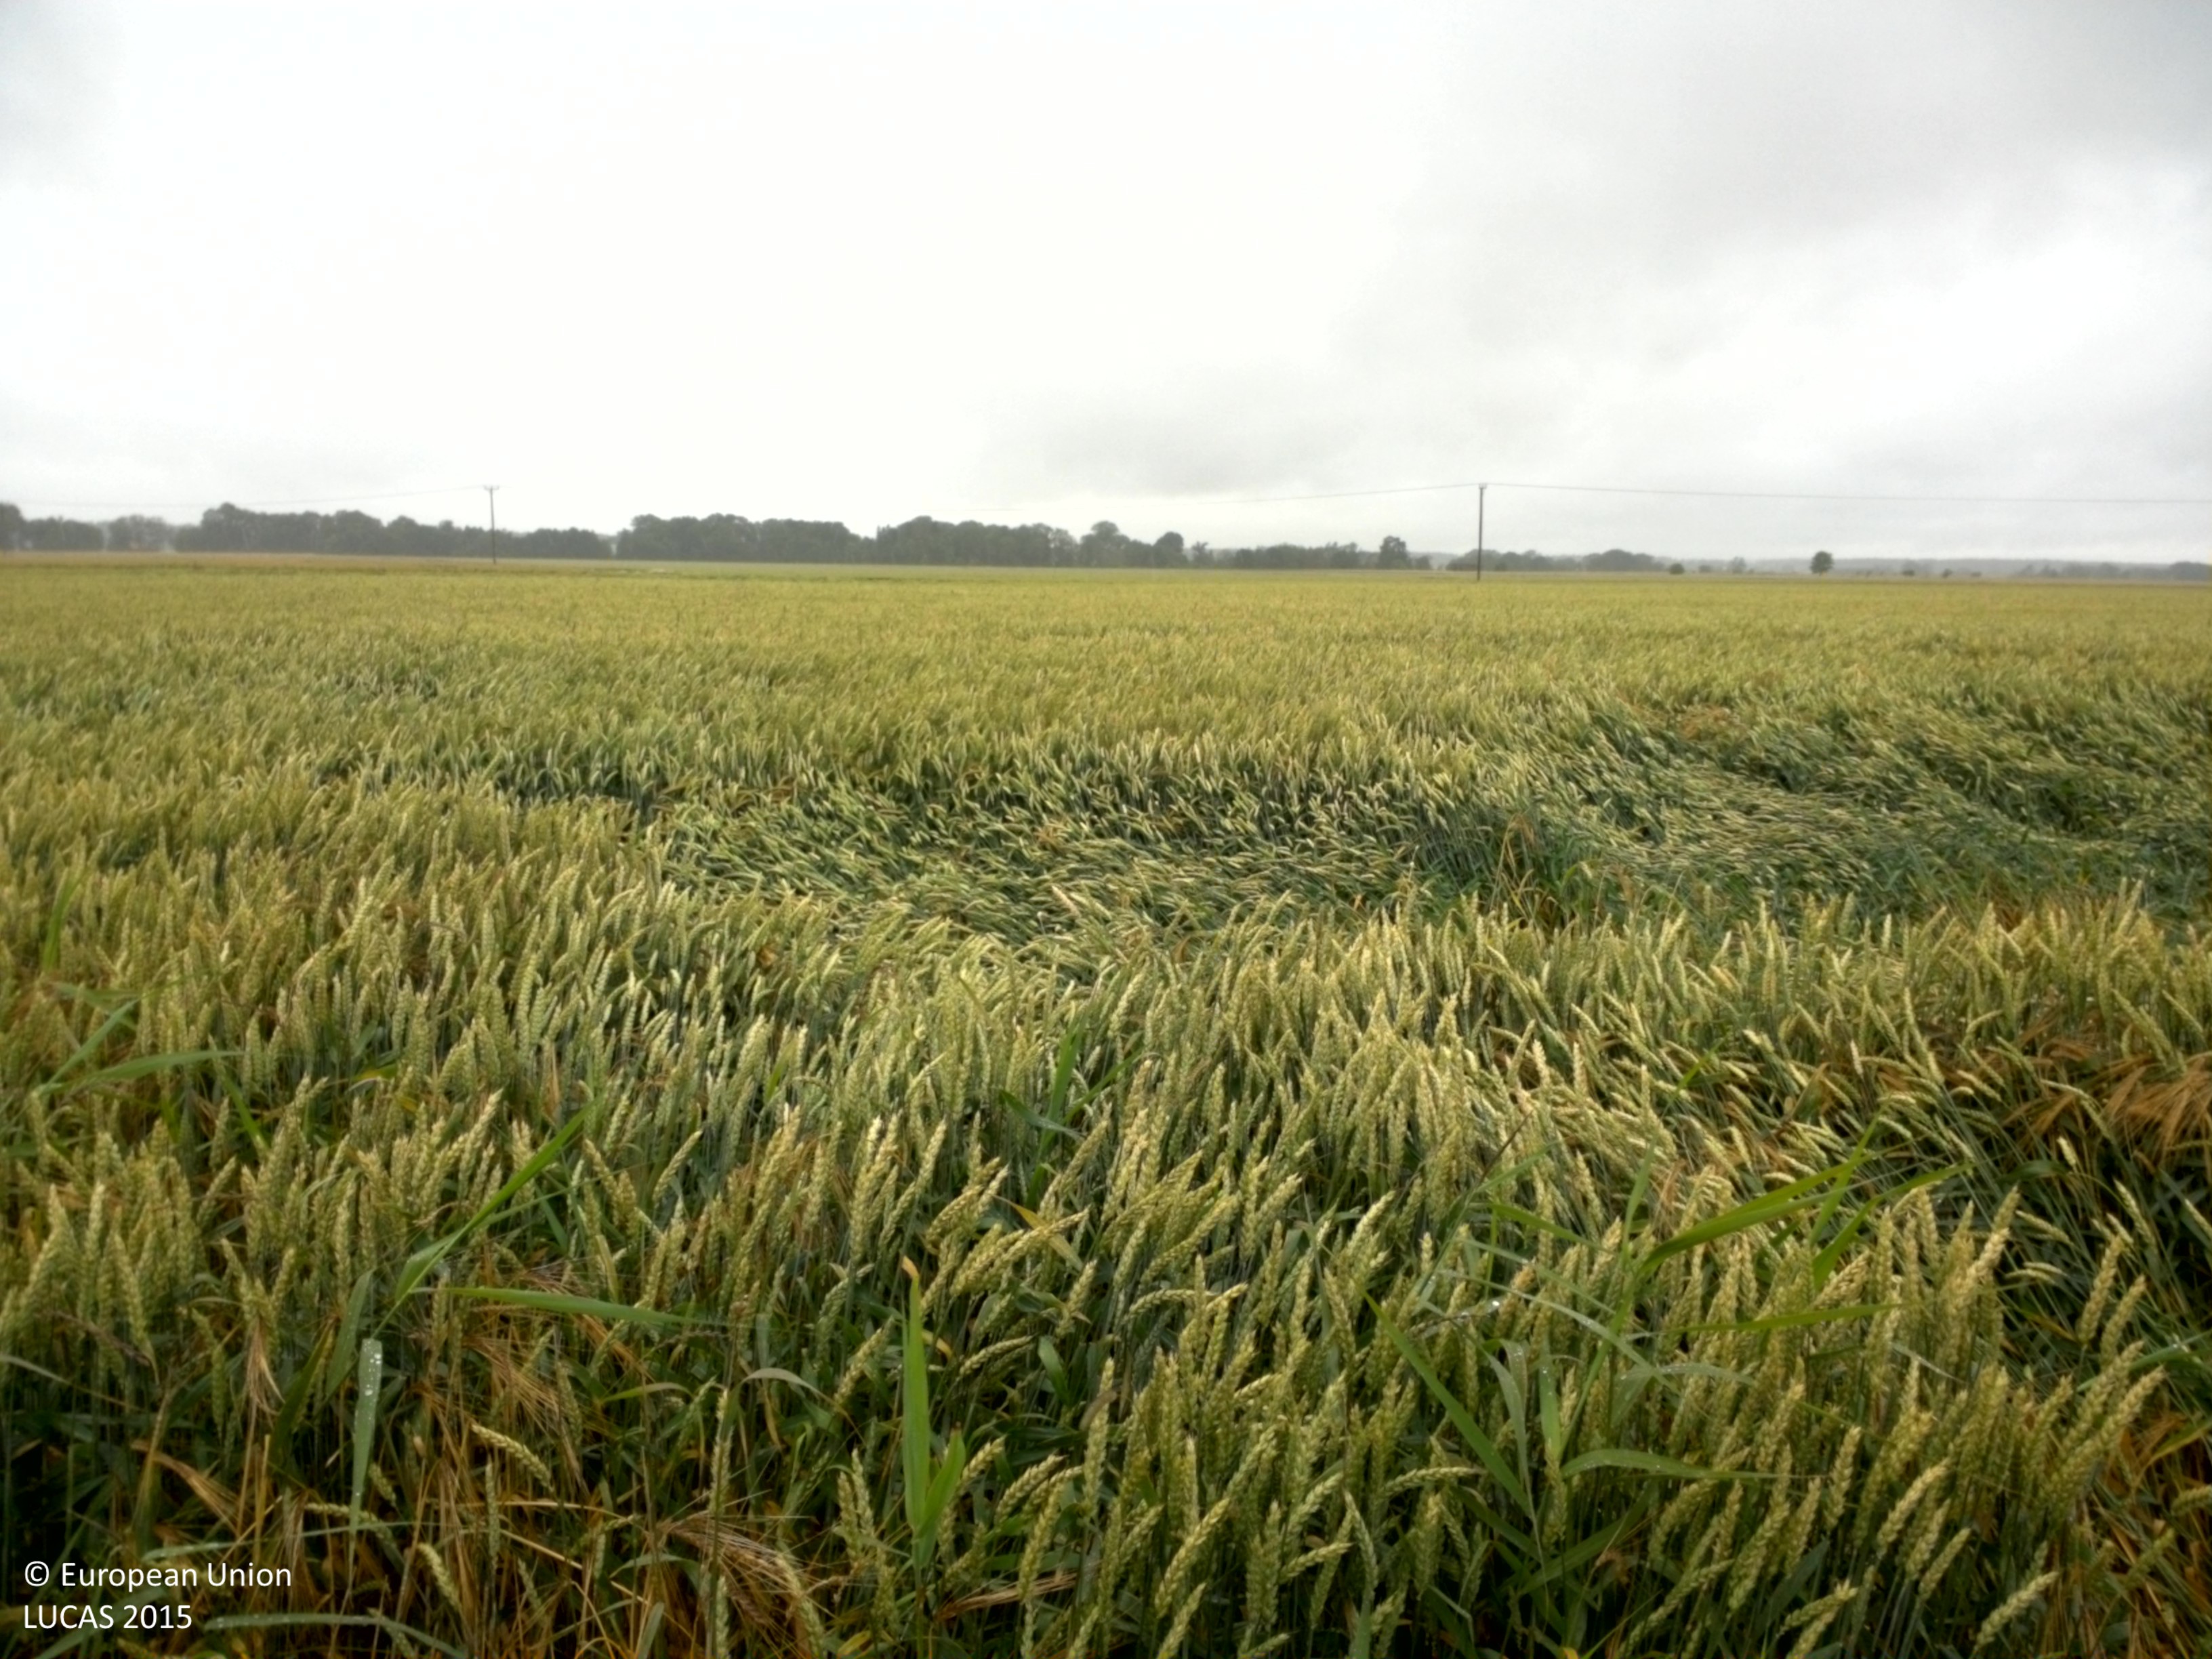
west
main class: Cropland
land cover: Common wheat
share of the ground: > 75 %
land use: Agriculture (excluding fallow land and kitchen gardens)
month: July
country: SE
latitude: 58.4678
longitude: 13.2685
